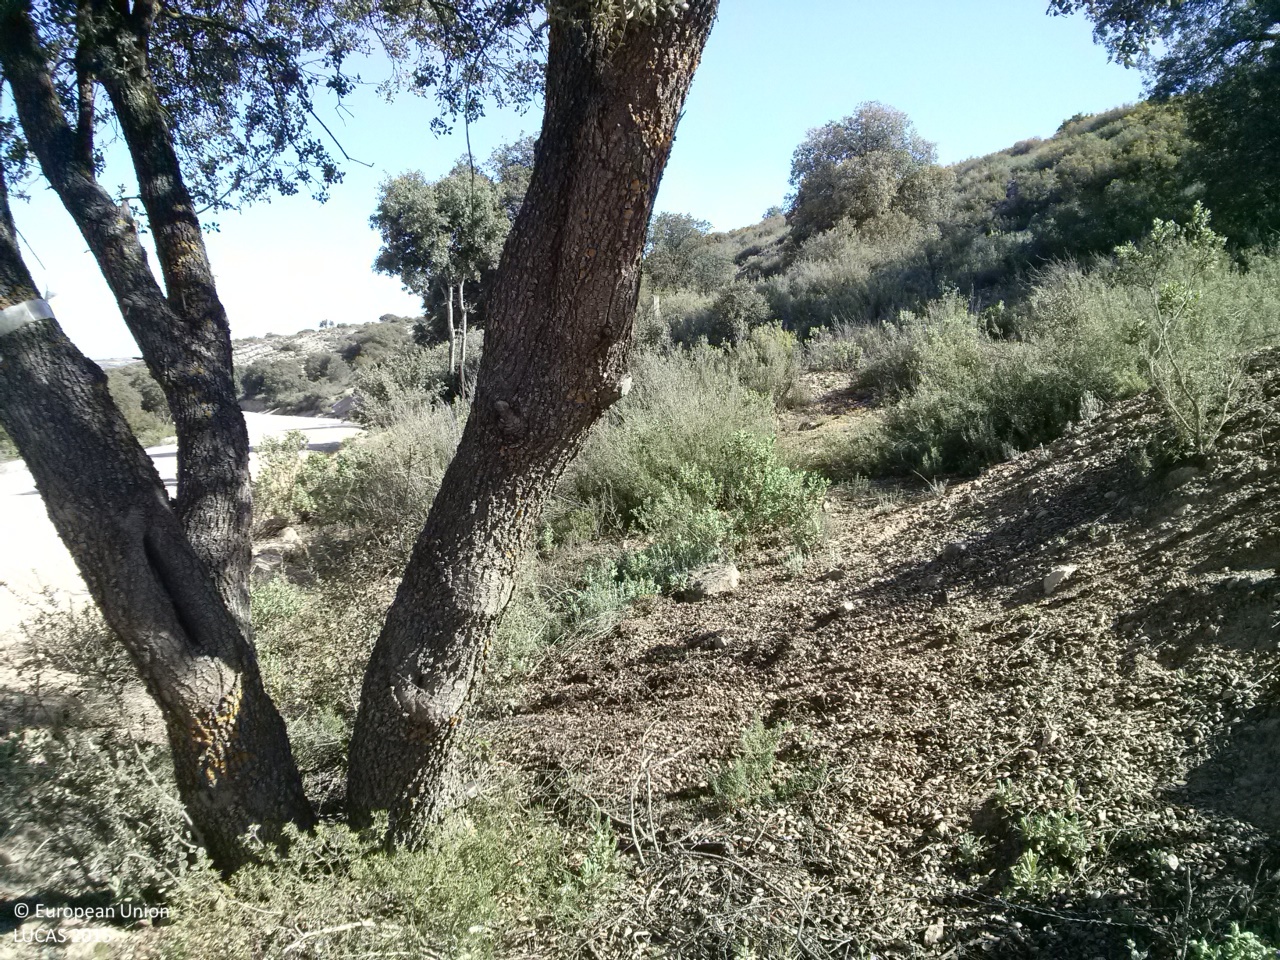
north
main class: Woodland
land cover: Broadleaved woodland
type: broadleaved evergreen forest
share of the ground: 10 - 25 %
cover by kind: shrubs 50 %, broadleaved forest trees 25 %, unconsolidated bare surface 25 %
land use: Forestry
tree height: > 5 m
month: May
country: ES
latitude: 39.8676
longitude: -2.7741
